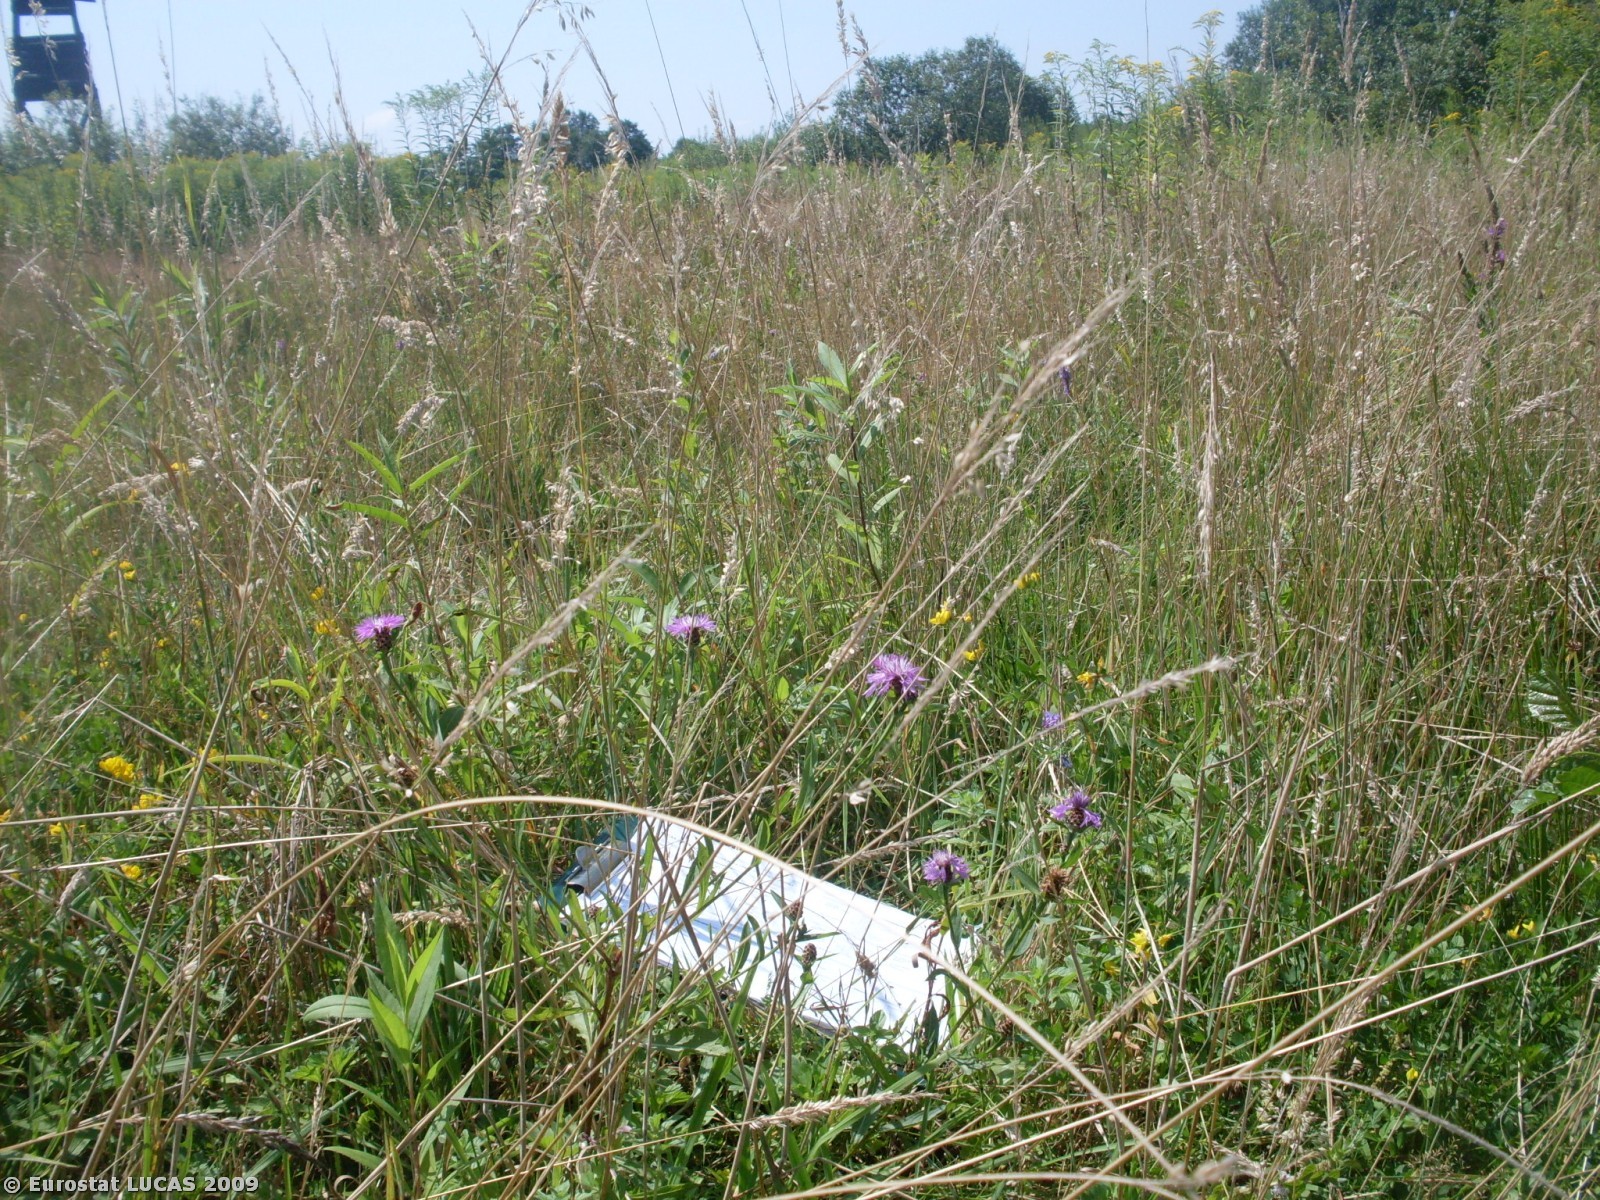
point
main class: Grassland
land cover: Grassland without tree/shrub cover
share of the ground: > 75 %
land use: Unused
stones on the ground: < 10 %
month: August
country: PL
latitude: 49.9971
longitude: 20.5991
